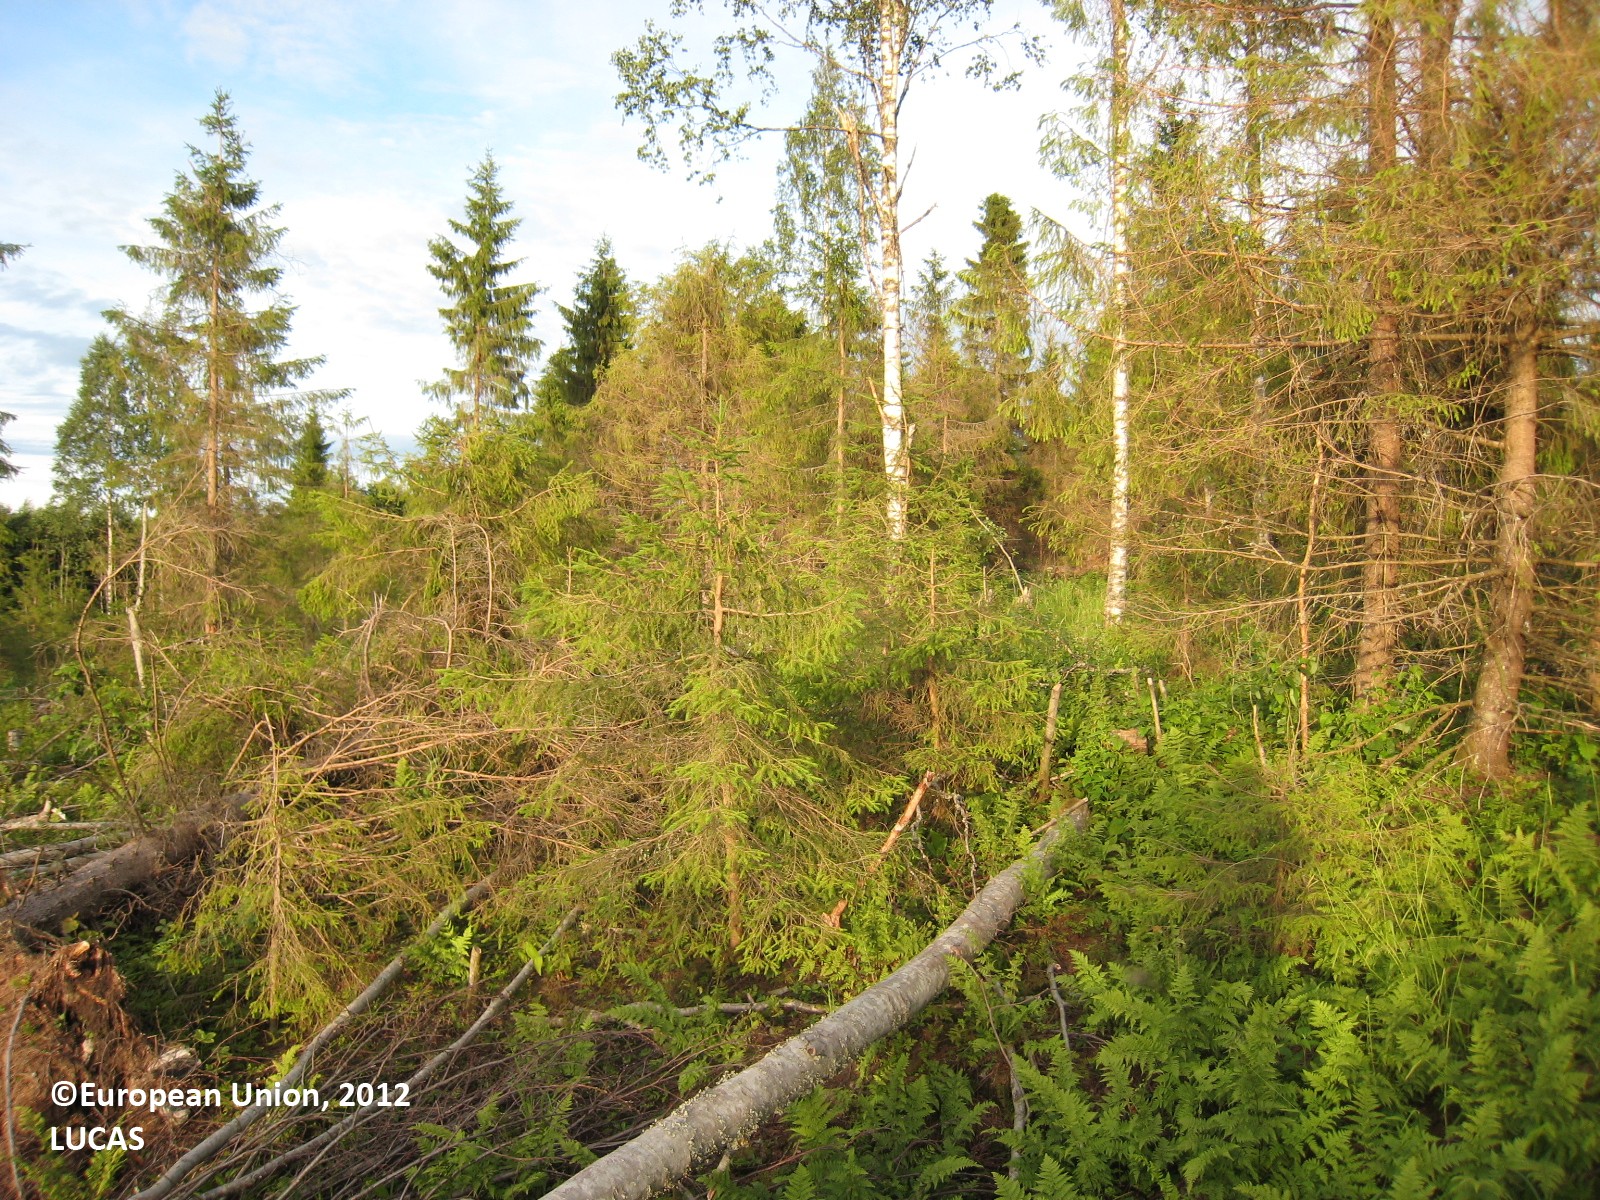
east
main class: Woodland
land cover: Spruce dominated coniferous woodland
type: boreal forest
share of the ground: 25 - 50 %
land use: Forestry
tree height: > 5 m
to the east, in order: Spruce dominated coniferous woodland; Spruce dominated mixed woodland; Ditches and canals; Spruce dominated mixed woodland; Ditches and canals; Spruce dominated mixed woodland
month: July
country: FI
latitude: 63.1636
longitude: 26.9195
